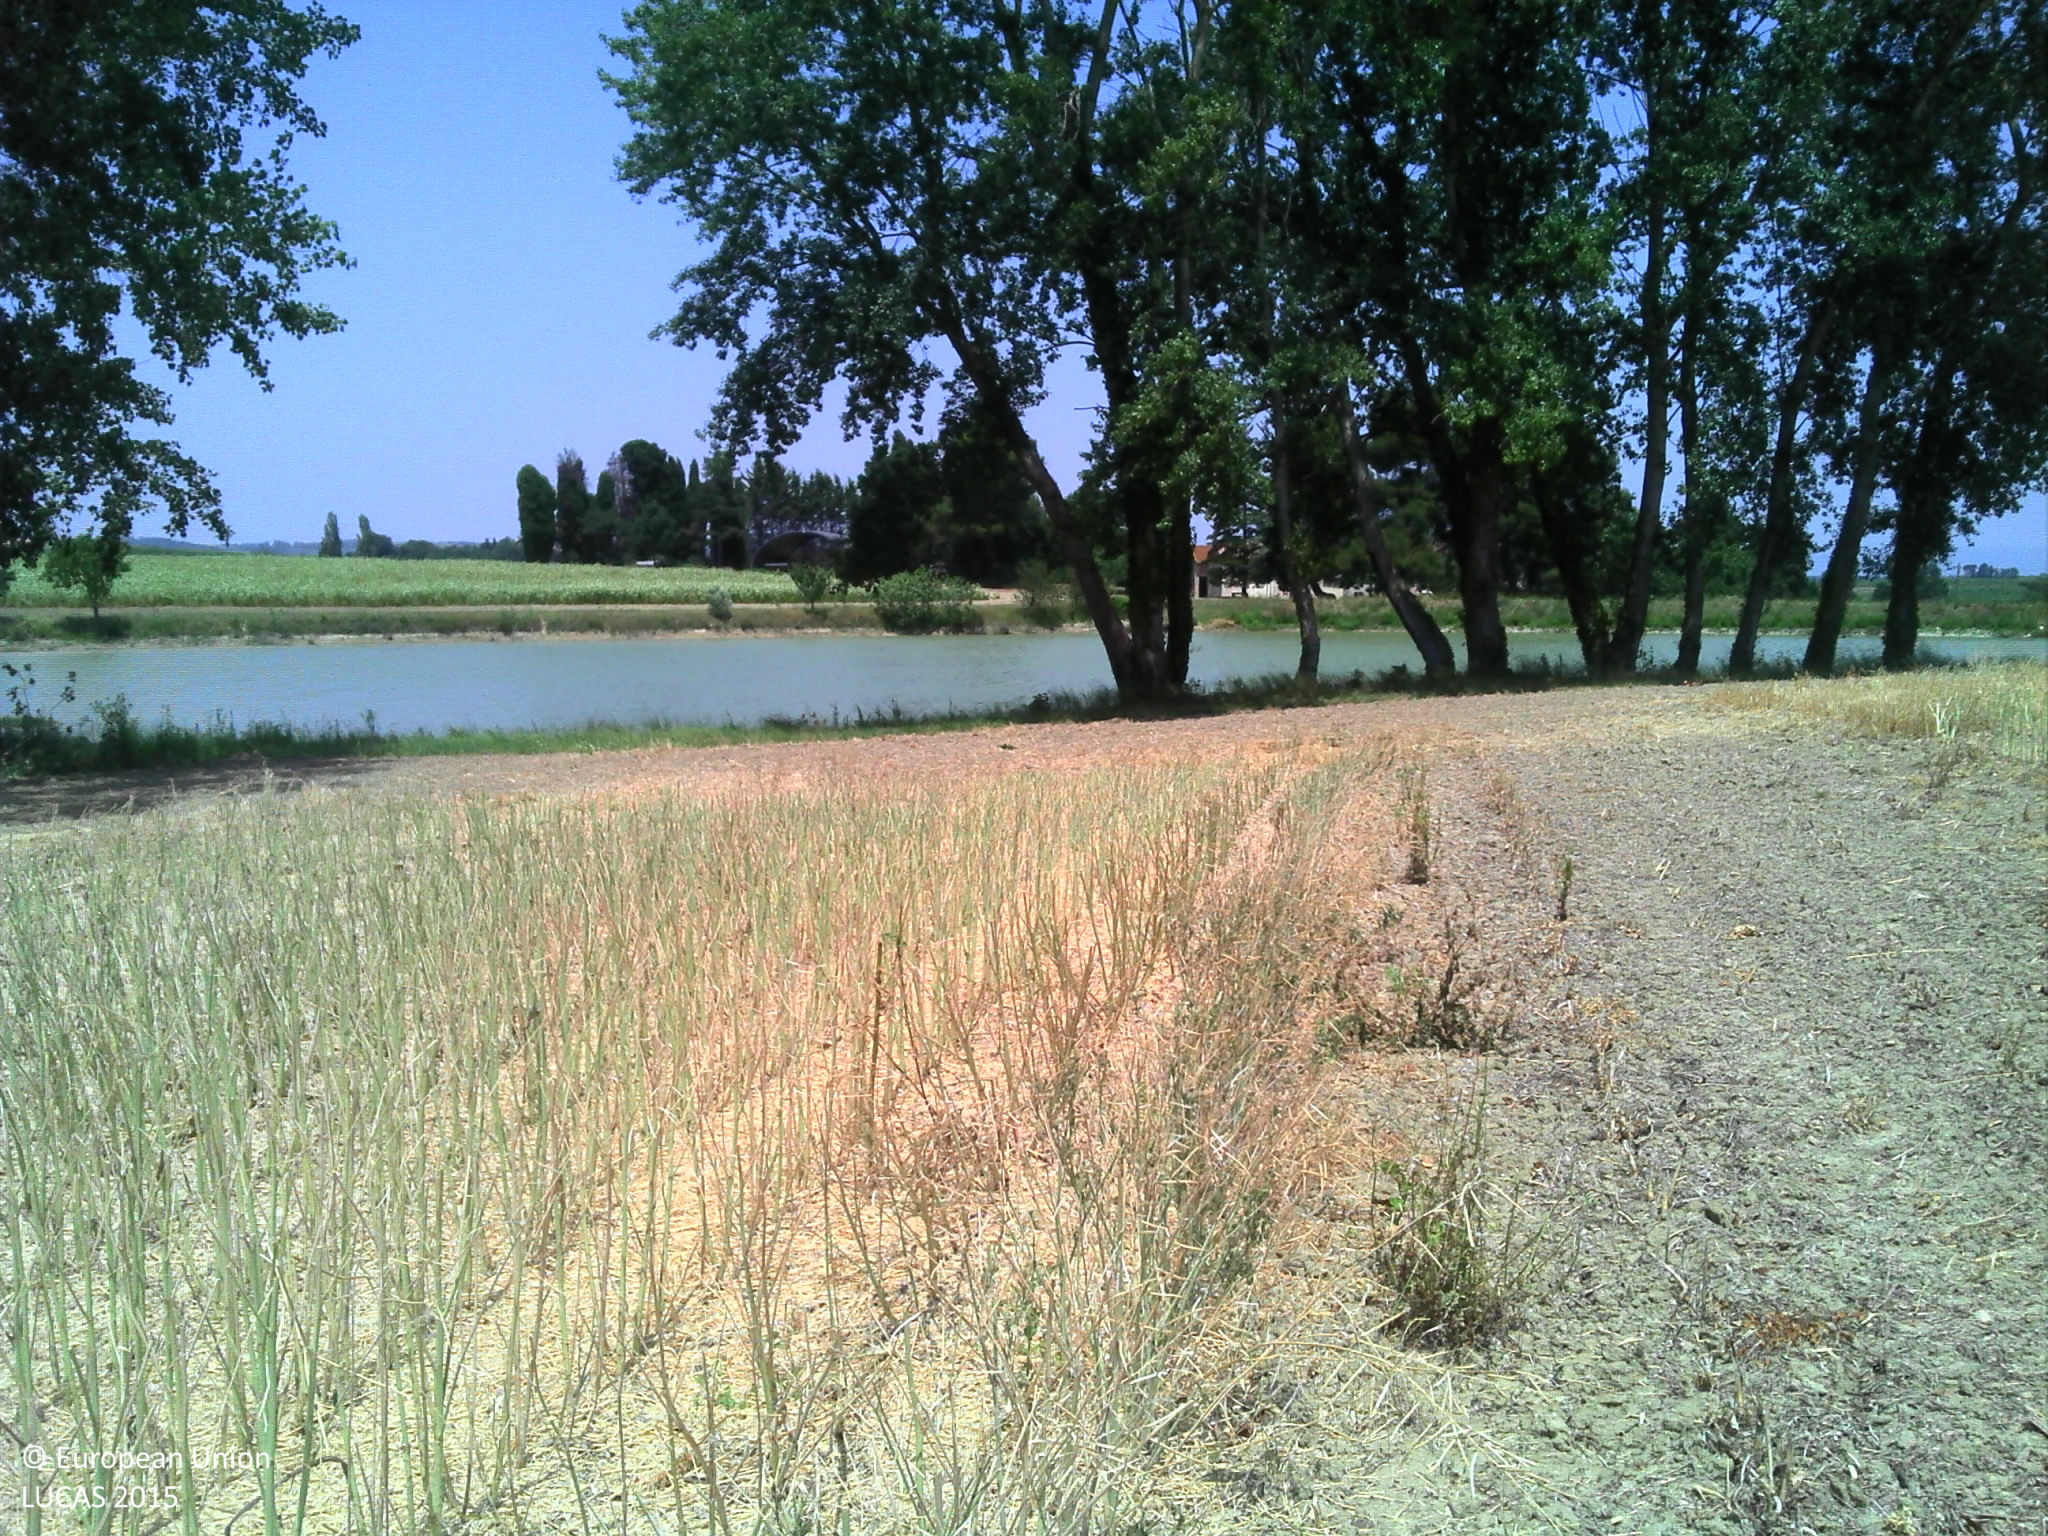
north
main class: Cropland
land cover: Rape and turnip rape
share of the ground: > 75 %
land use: Agriculture (excluding fallow land and kitchen gardens)
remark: Harvested field
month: July
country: FR
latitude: 43.1214
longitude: 2.0554
